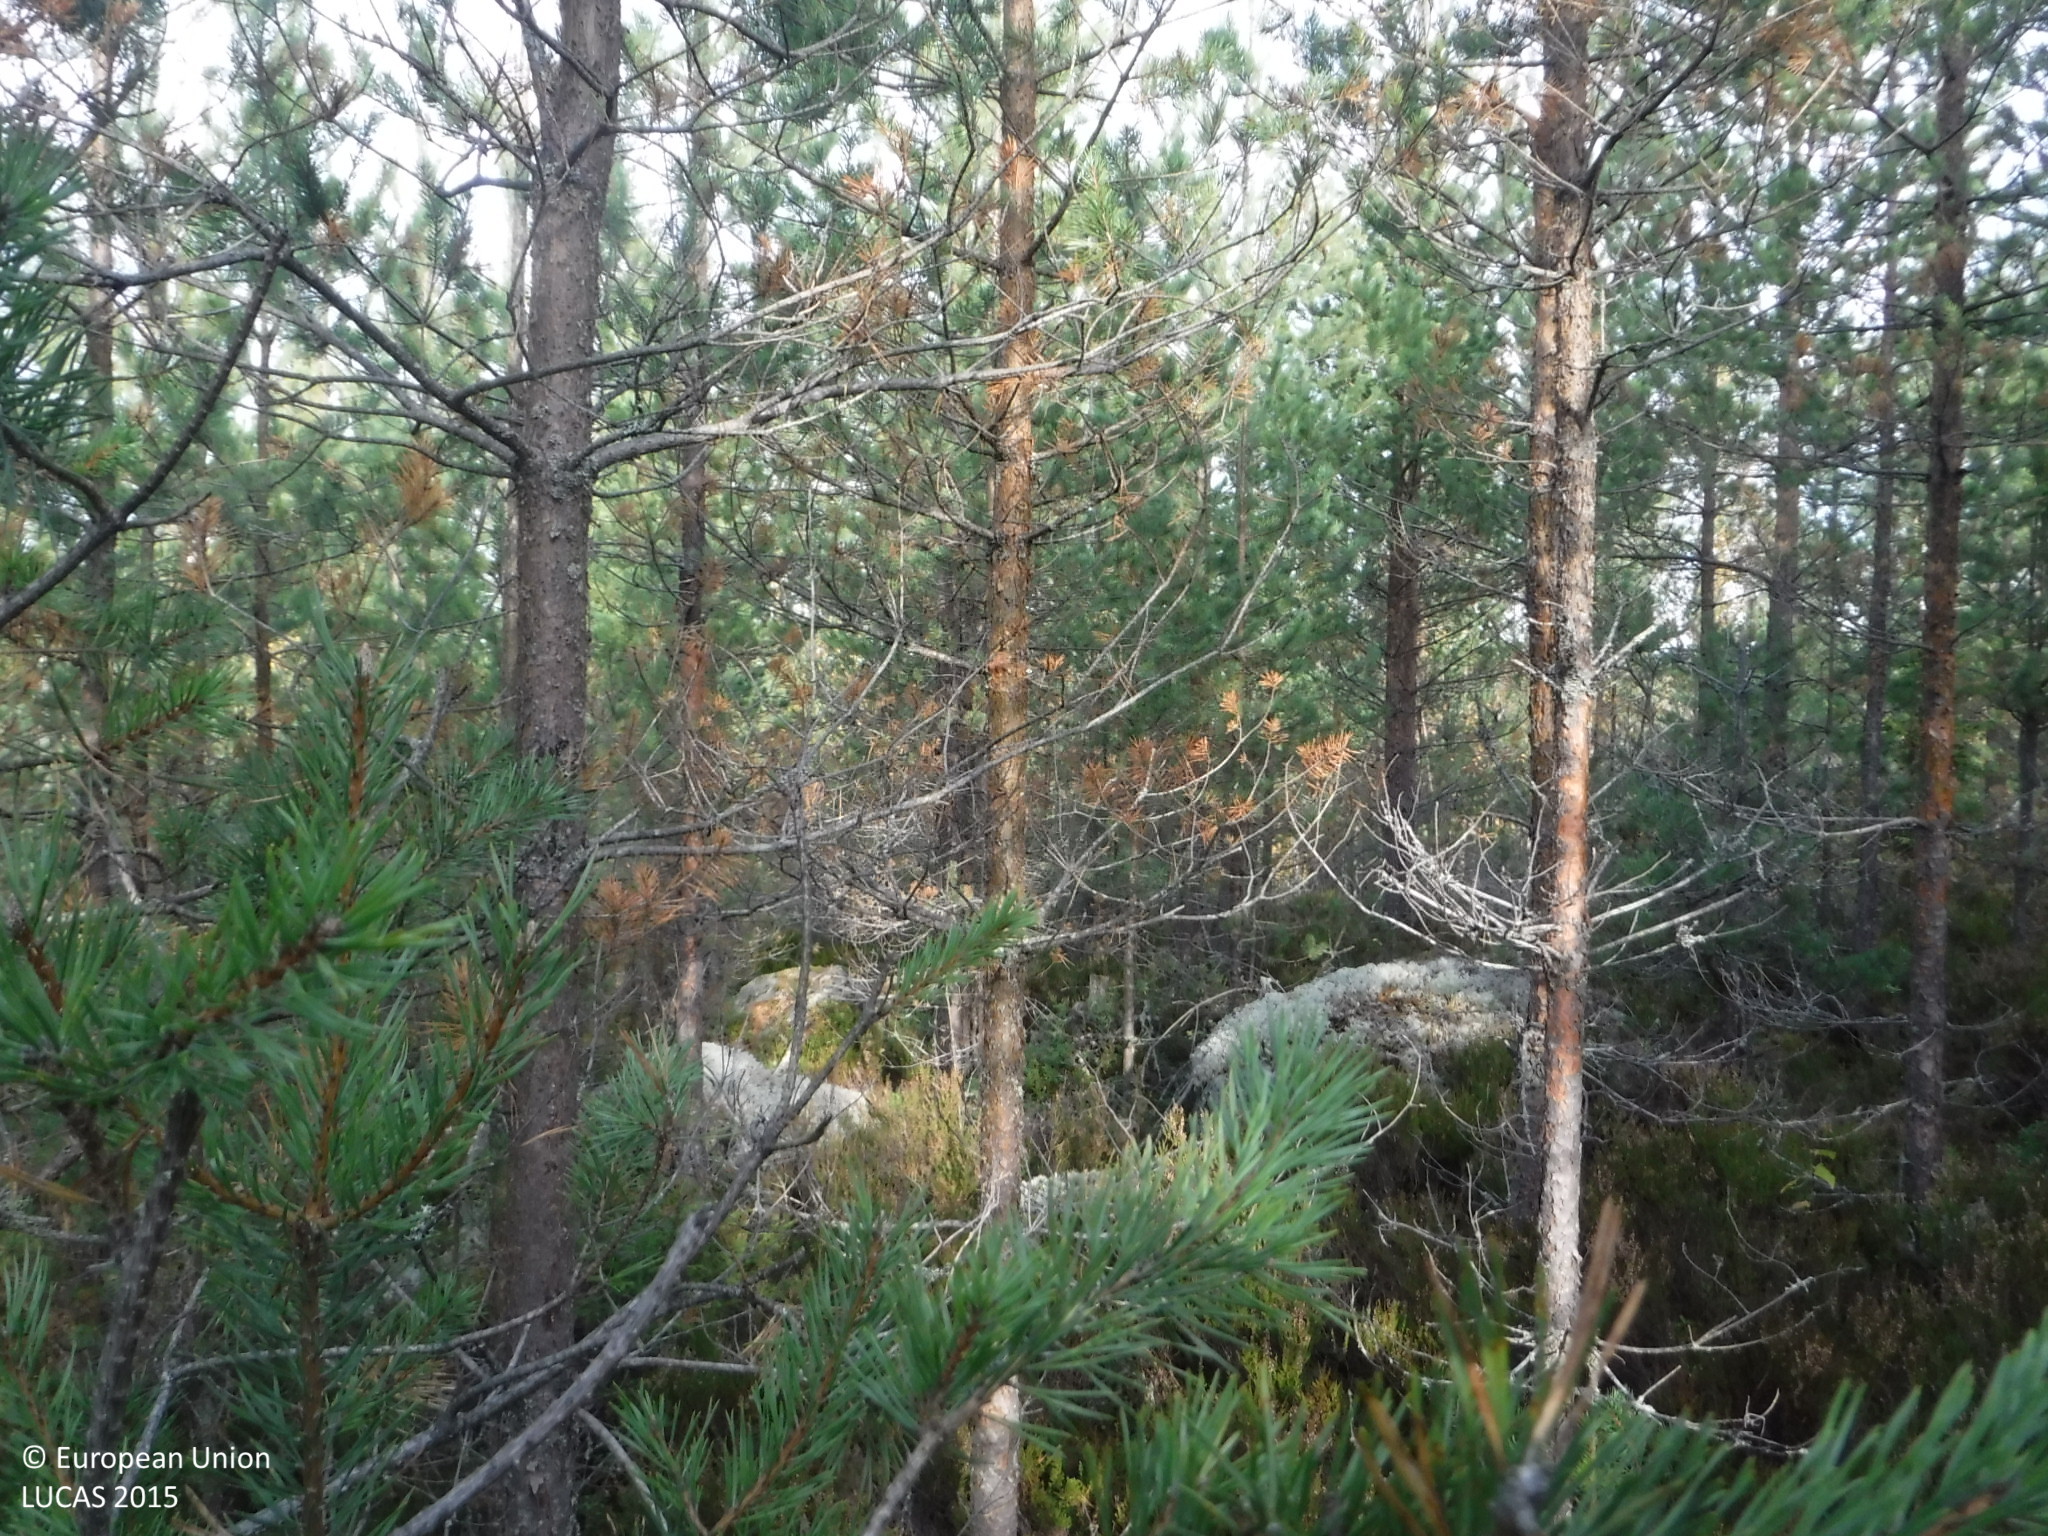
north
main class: Woodland
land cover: Pine dominated coniferous woodland
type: boreal forest
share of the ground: 50 - 75 %
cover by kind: coniferous forest trees 70 %, shrubs 15 %, lichens and mosses 15 %
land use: Forestry
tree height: < 5 m
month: October
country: FI
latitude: 62.0417
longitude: 26.0178
